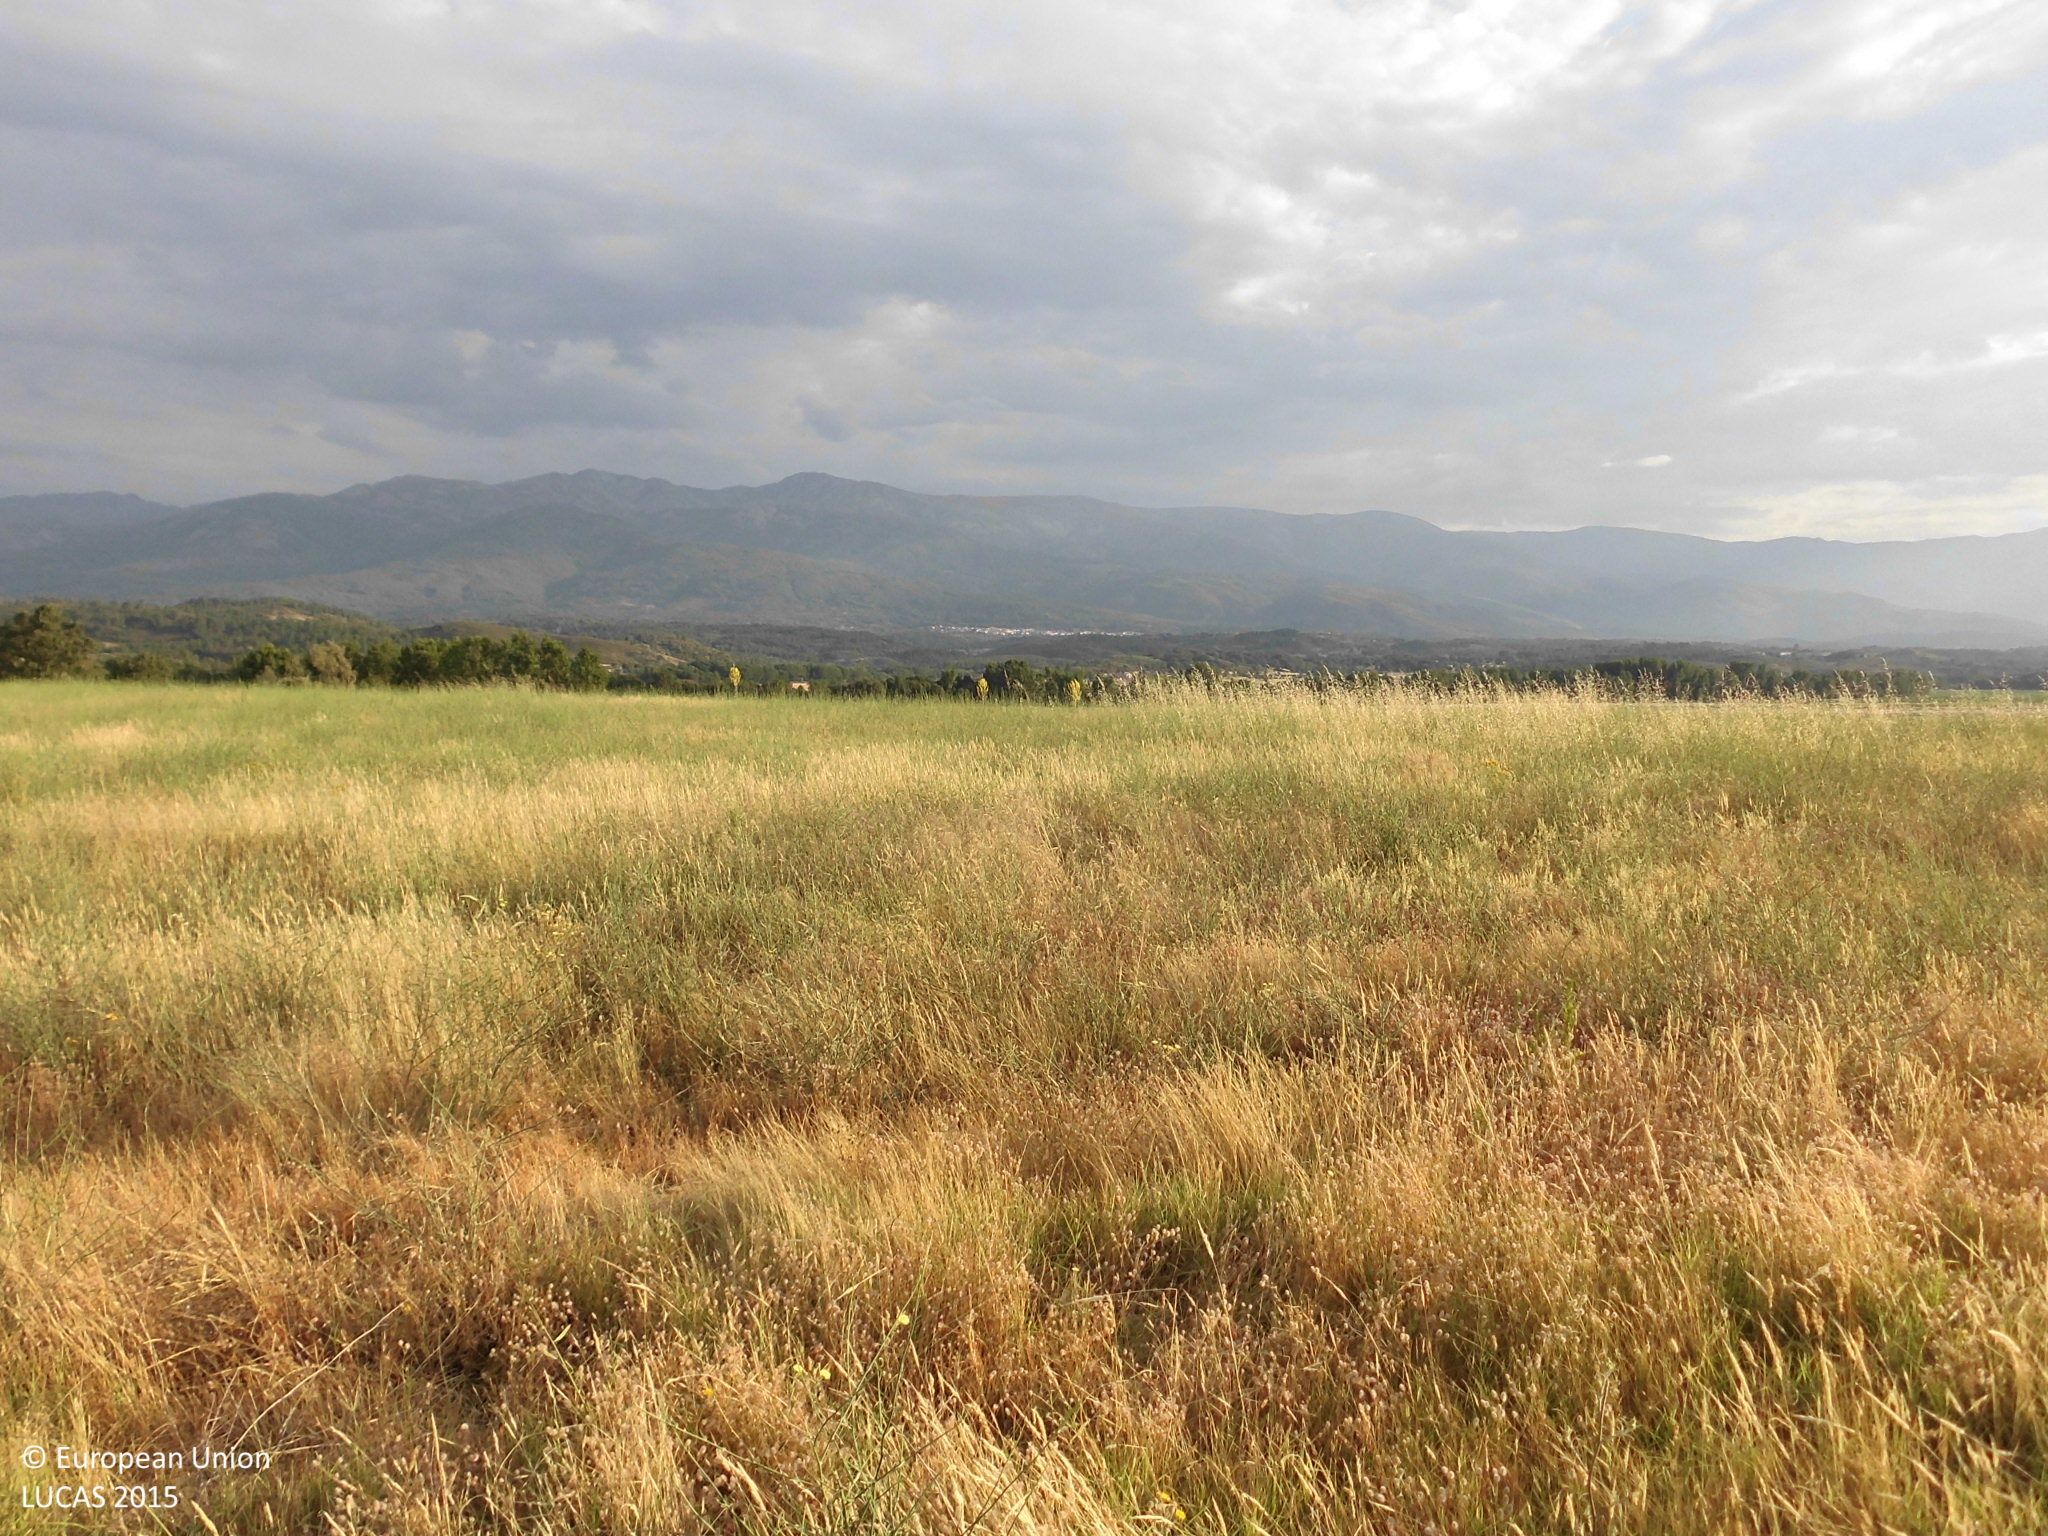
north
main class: Grassland
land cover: Spontaneously vegetated surfaces
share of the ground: > 75 %
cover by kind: herbaceous plants 100 %
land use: Fallow land
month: June
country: ES
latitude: 40.0639
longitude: -5.4538
